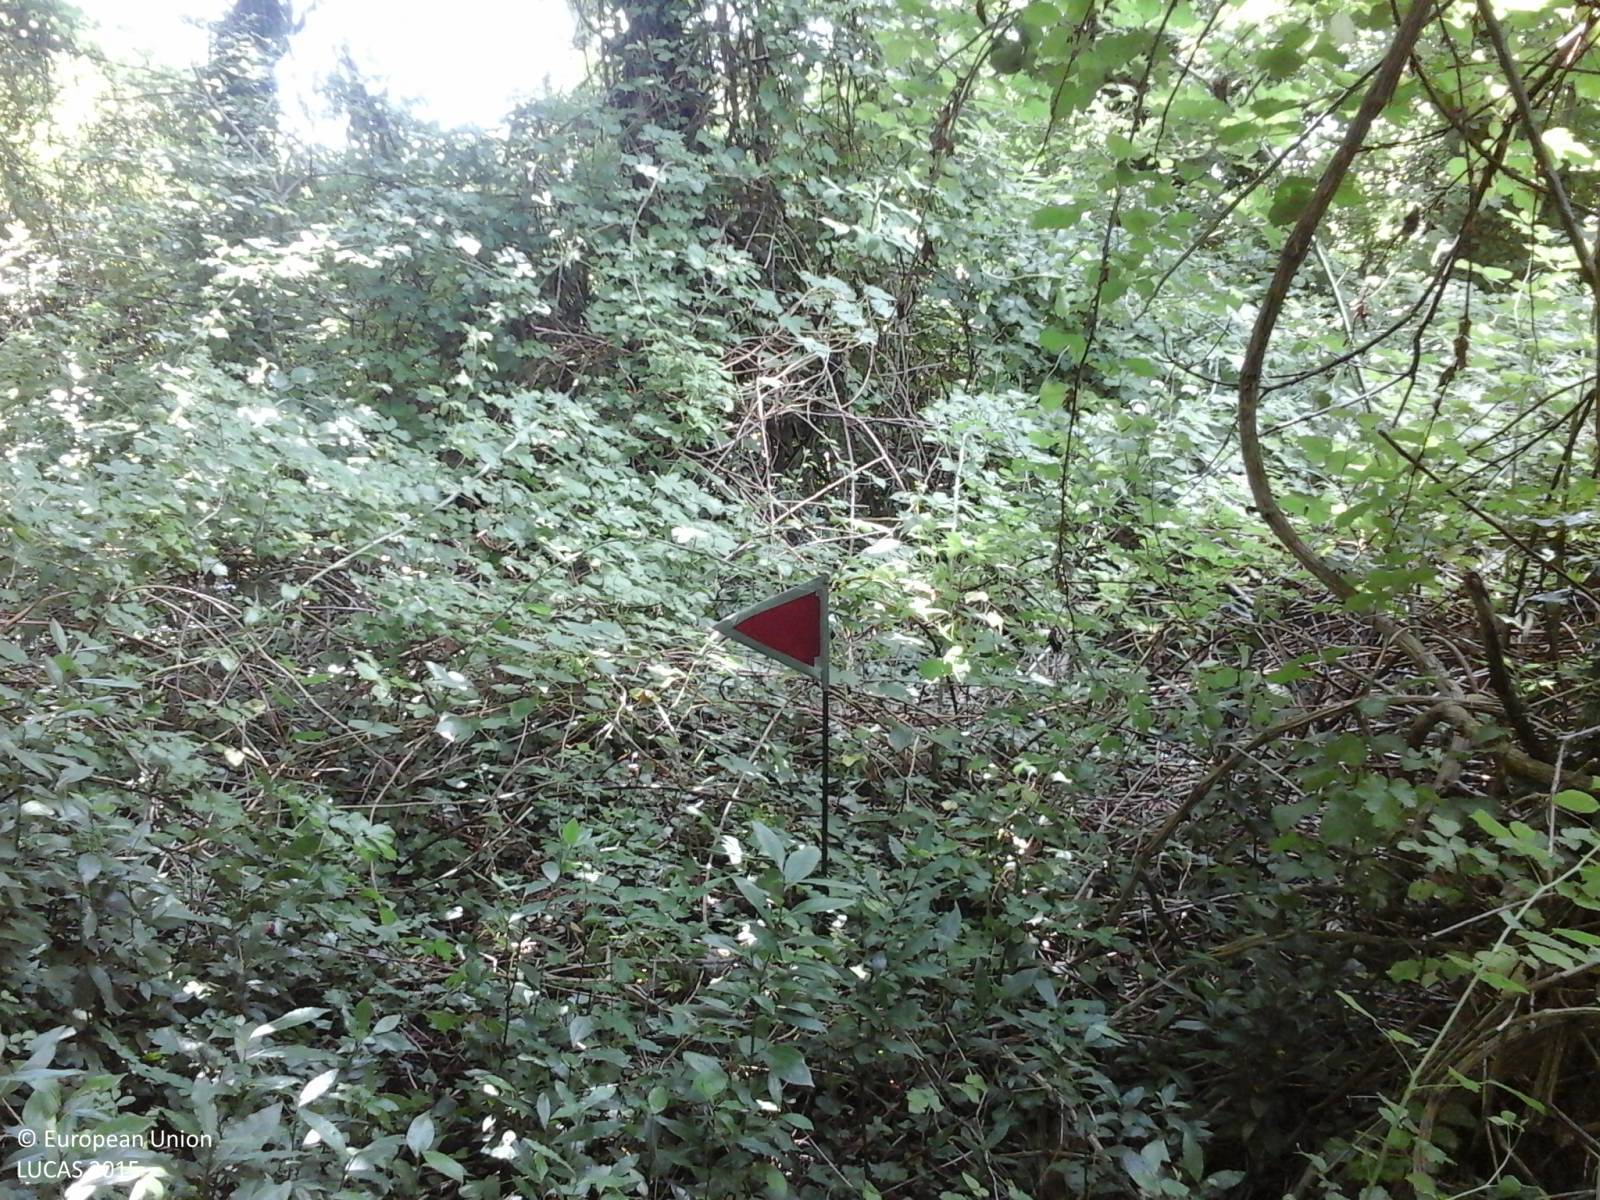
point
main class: Woodland
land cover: Broadleaved woodland
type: thermophilous deciduous forest
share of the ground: > 75 %
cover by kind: broadleaved forest trees 80 %, shrubs 20 %
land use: Semi-natural and natural areas not in use
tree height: > 5 m
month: June
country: IT
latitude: 45.7863
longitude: 13.5846
